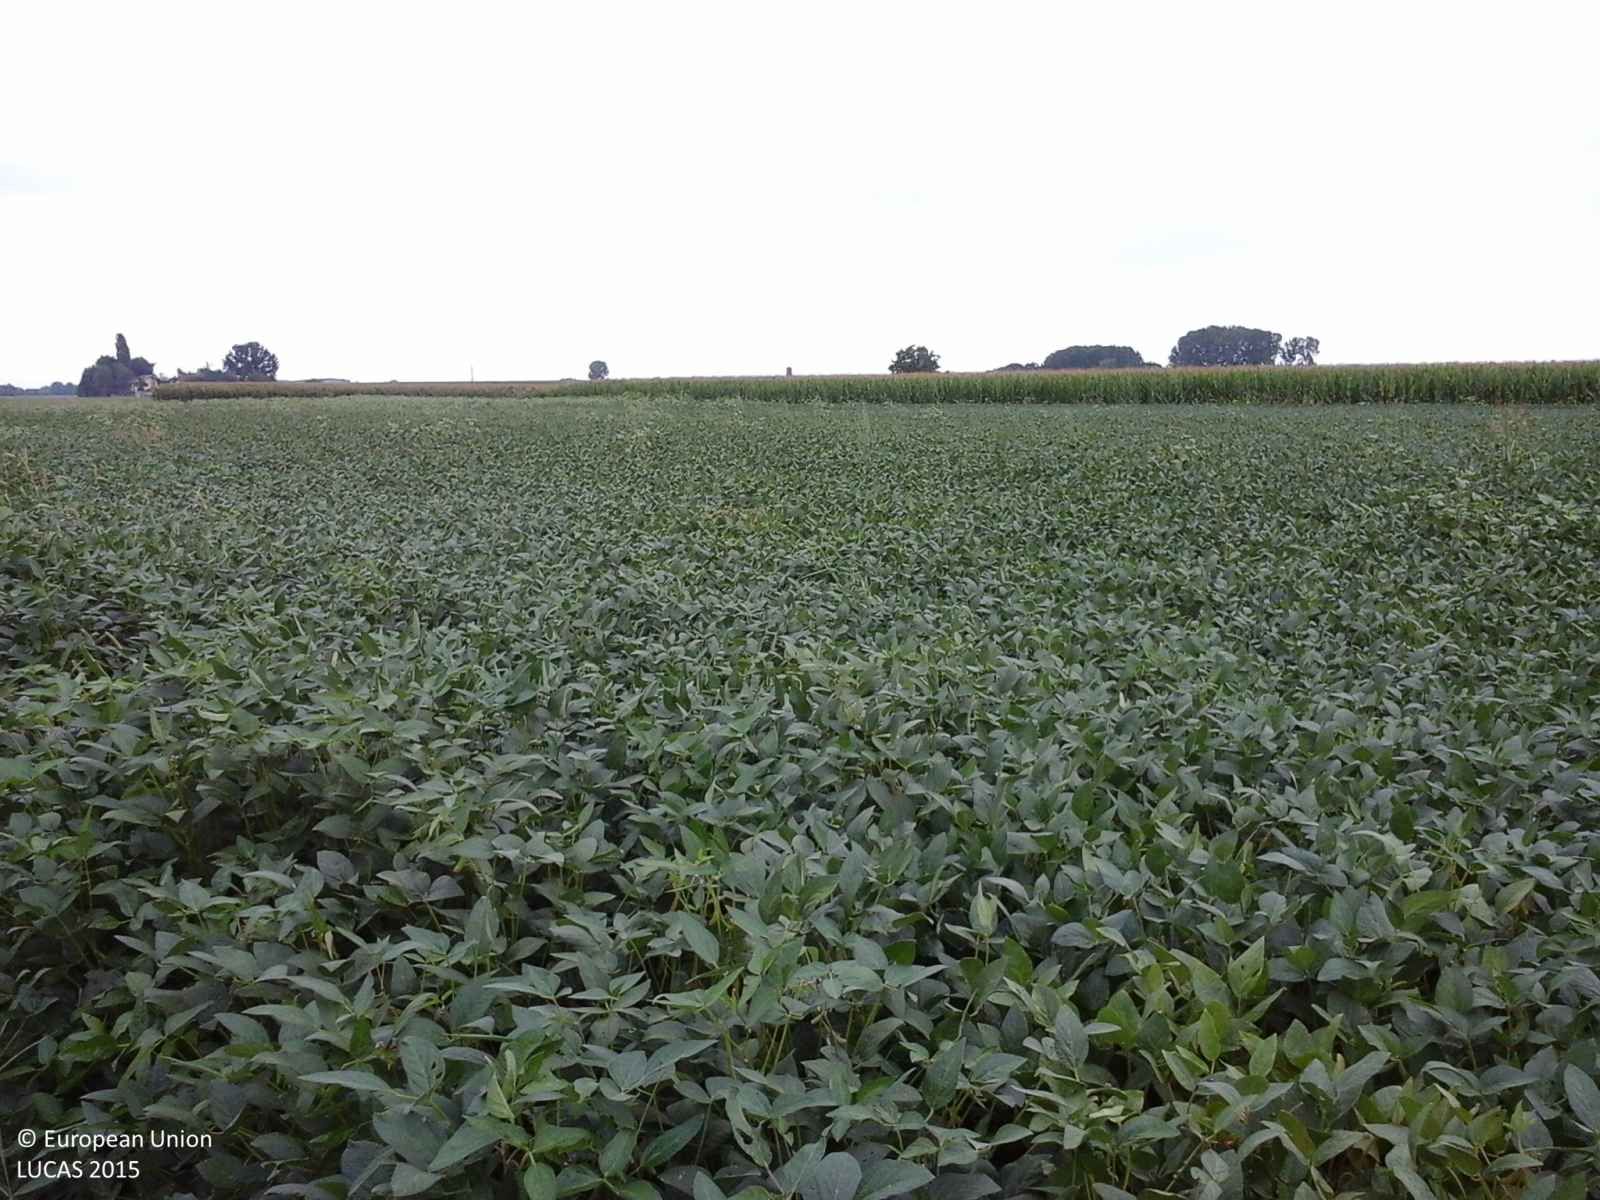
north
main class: Cropland
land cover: Soya
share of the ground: > 75 %
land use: Agriculture (excluding fallow land and kitchen gardens)
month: July
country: IT
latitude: 44.7950
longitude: 7.7416
